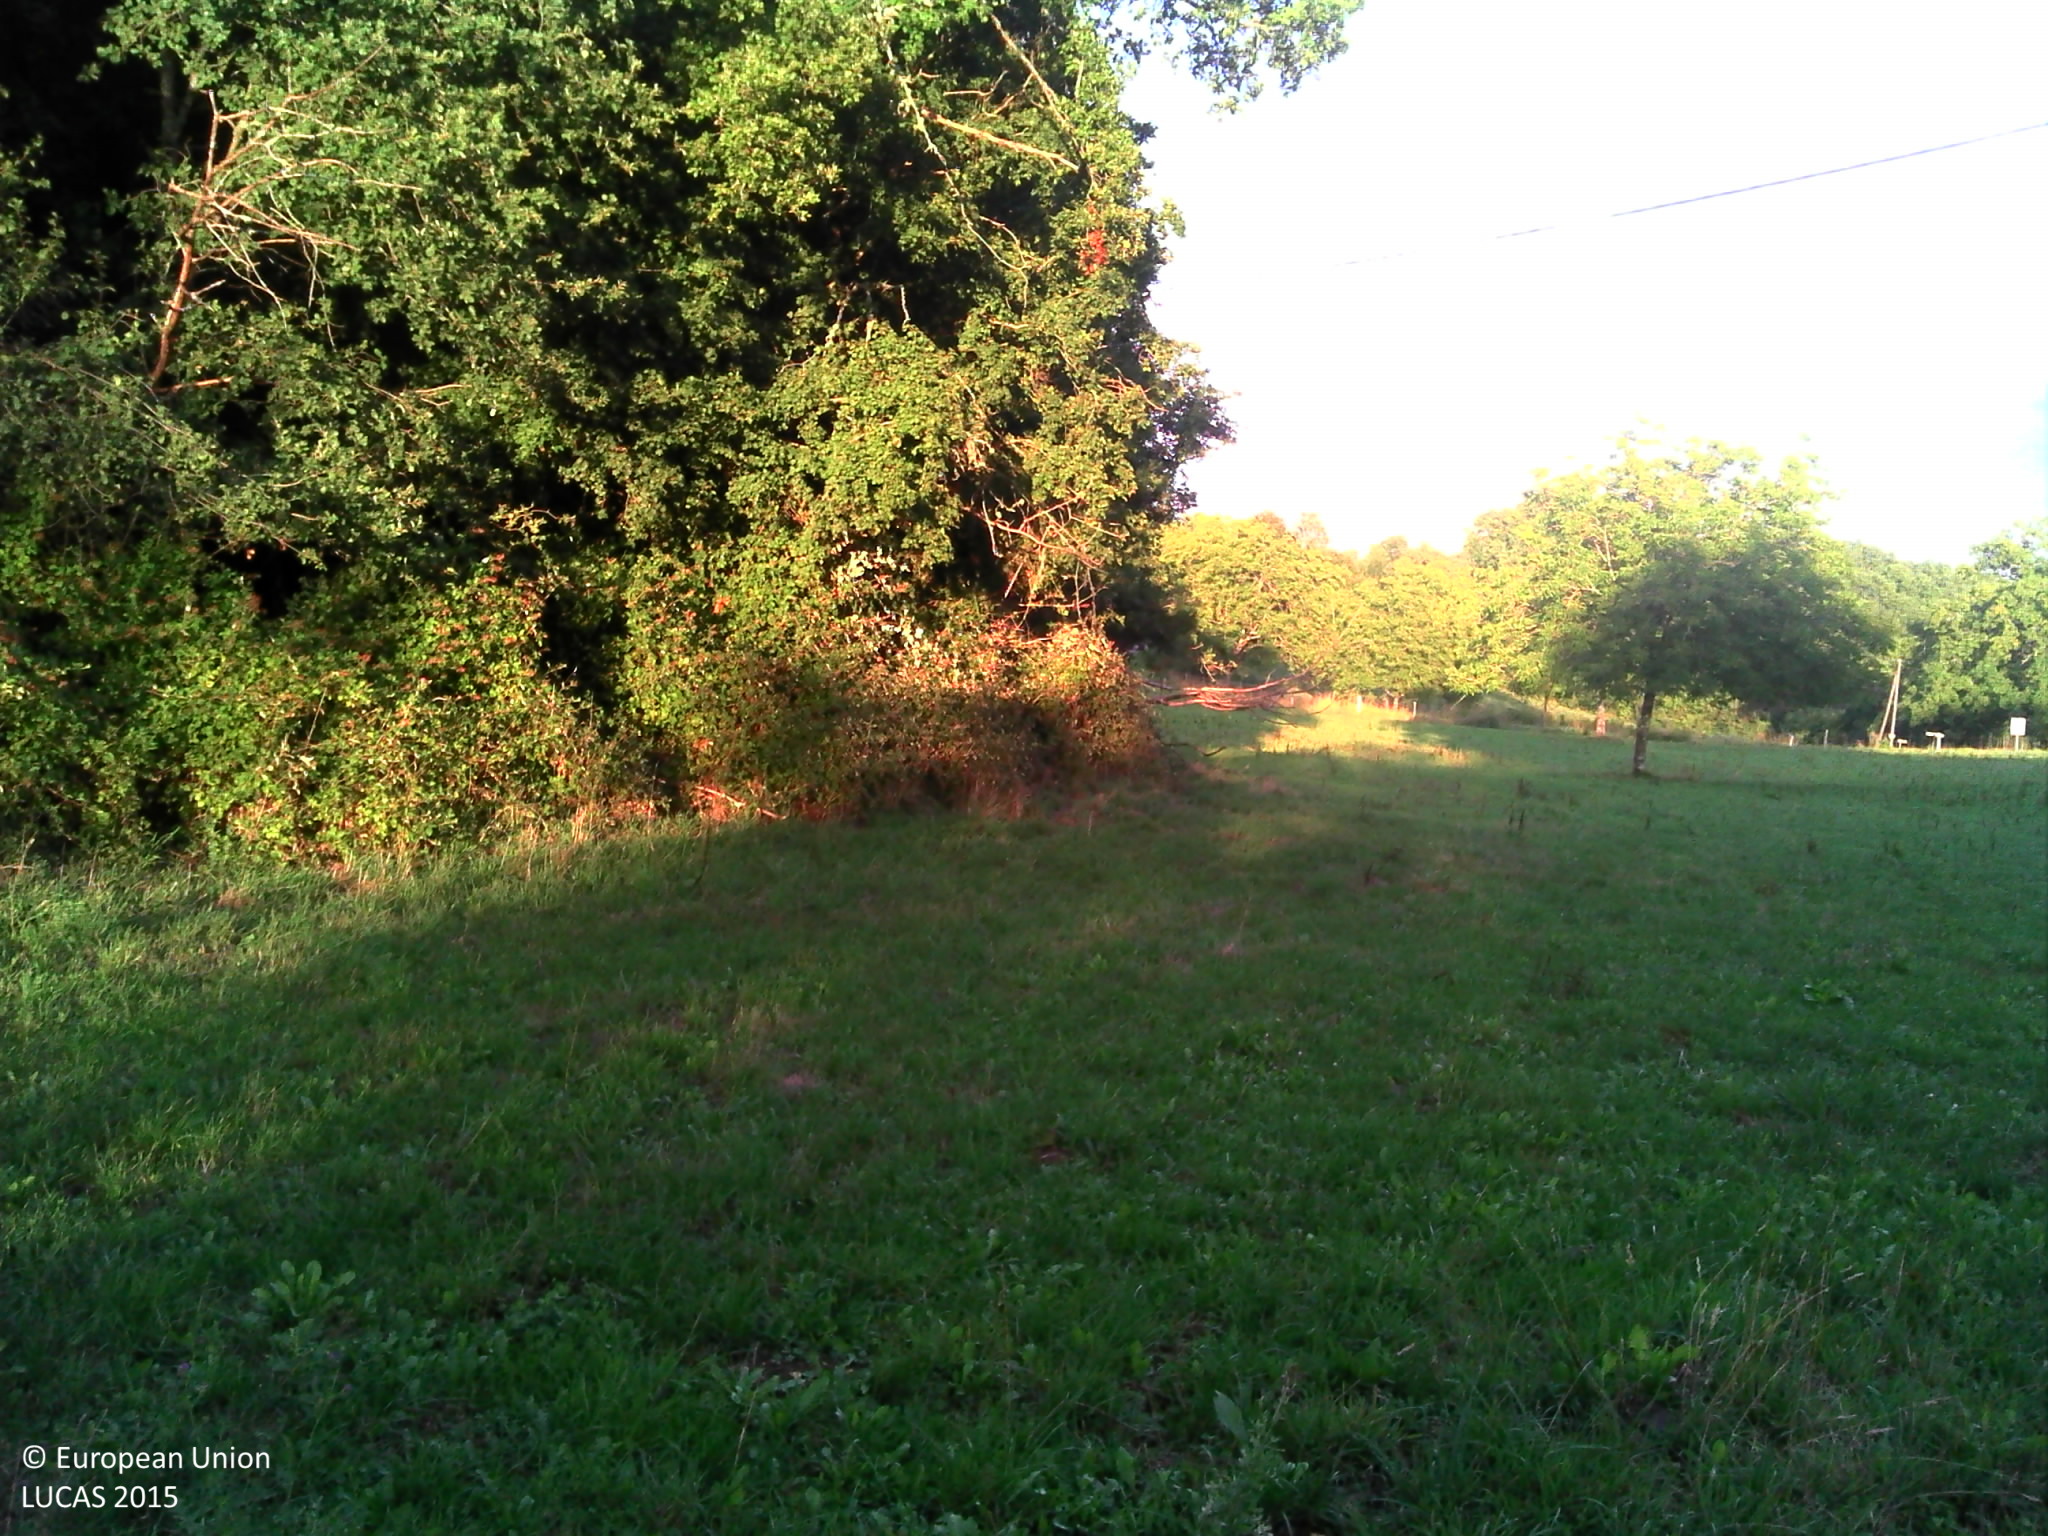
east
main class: Grassland
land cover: Grassland with sparse tree/shrub cover
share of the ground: > 75 %
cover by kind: herbaceous plants 95 %, broadleaved forest trees 5 %
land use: Agriculture (excluding fallow land and kitchen gardens)
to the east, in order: Grassland with sparse tree/shrub cover; Broadleaved woodland; Electric lines; Grassland without tree/shrub cover; Grassland with sparse tree/shrub cover; Fences; Grass margins; Paved roads, cycling and walking lanes; Other bare soil
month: August
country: FR
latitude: 45.4350
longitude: 0.6698
